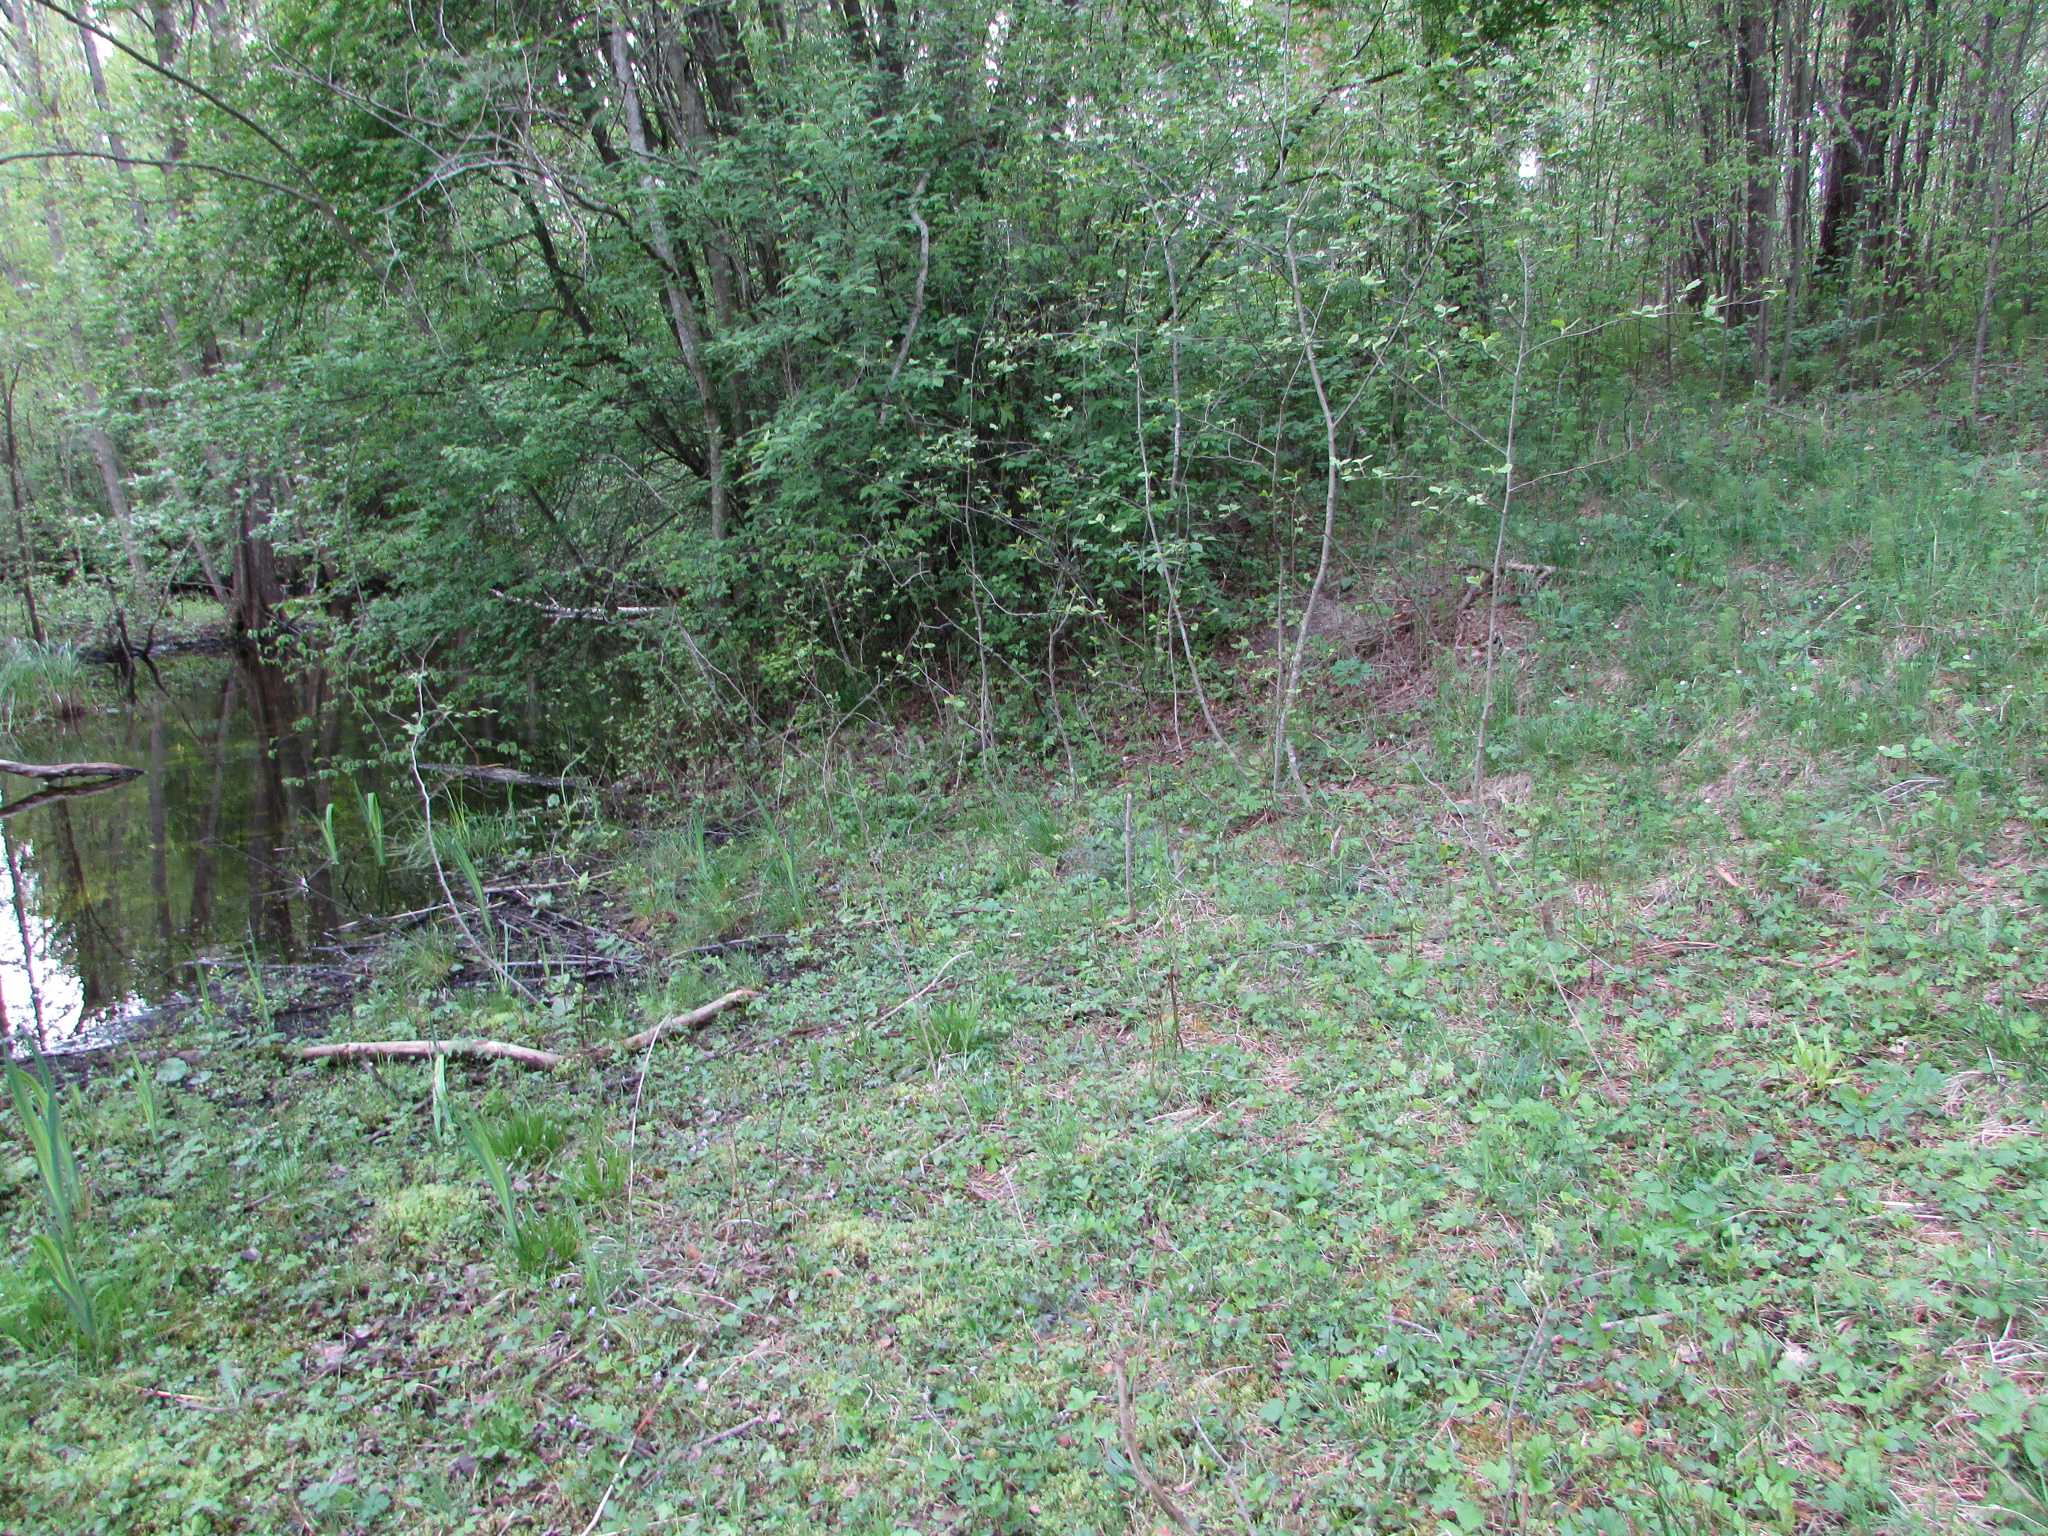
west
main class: Woodland
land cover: Pine dominated mixed woodland
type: hemiboreal forest and nemoral coniferous forest and mixed broadleaved-coniferous forest
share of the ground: > 75 %
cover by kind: coniferous forest trees 60 %, broadleaved forest trees 40 %
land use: Forestry
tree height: > 5 m
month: May
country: LV
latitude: 56.1402
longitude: 27.1809
